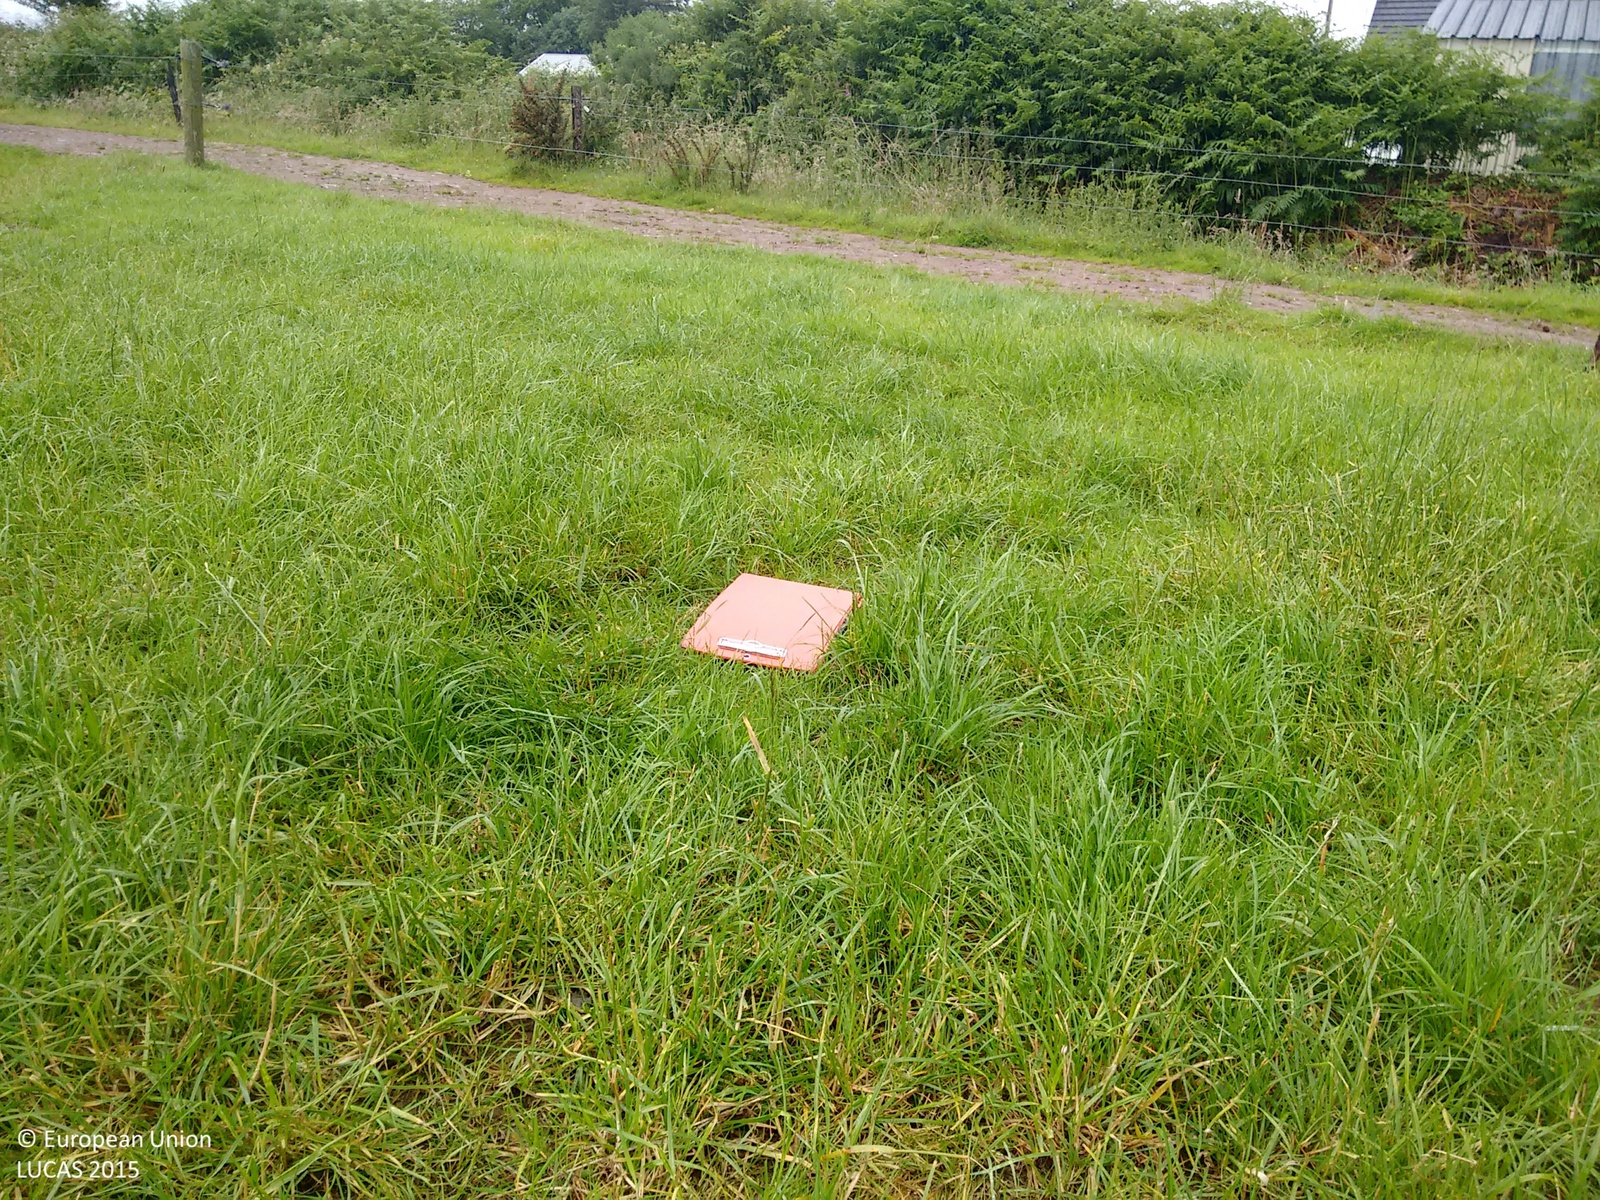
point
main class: Grassland
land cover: Grassland without tree/shrub cover
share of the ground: > 75 %
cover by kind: herbaceous plants 90 %, shrubs 5 %, unconsolidated bare surface 5 %
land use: Agriculture (excluding fallow land and kitchen gardens)
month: July
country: IE
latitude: 52.1910
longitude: -8.1902
